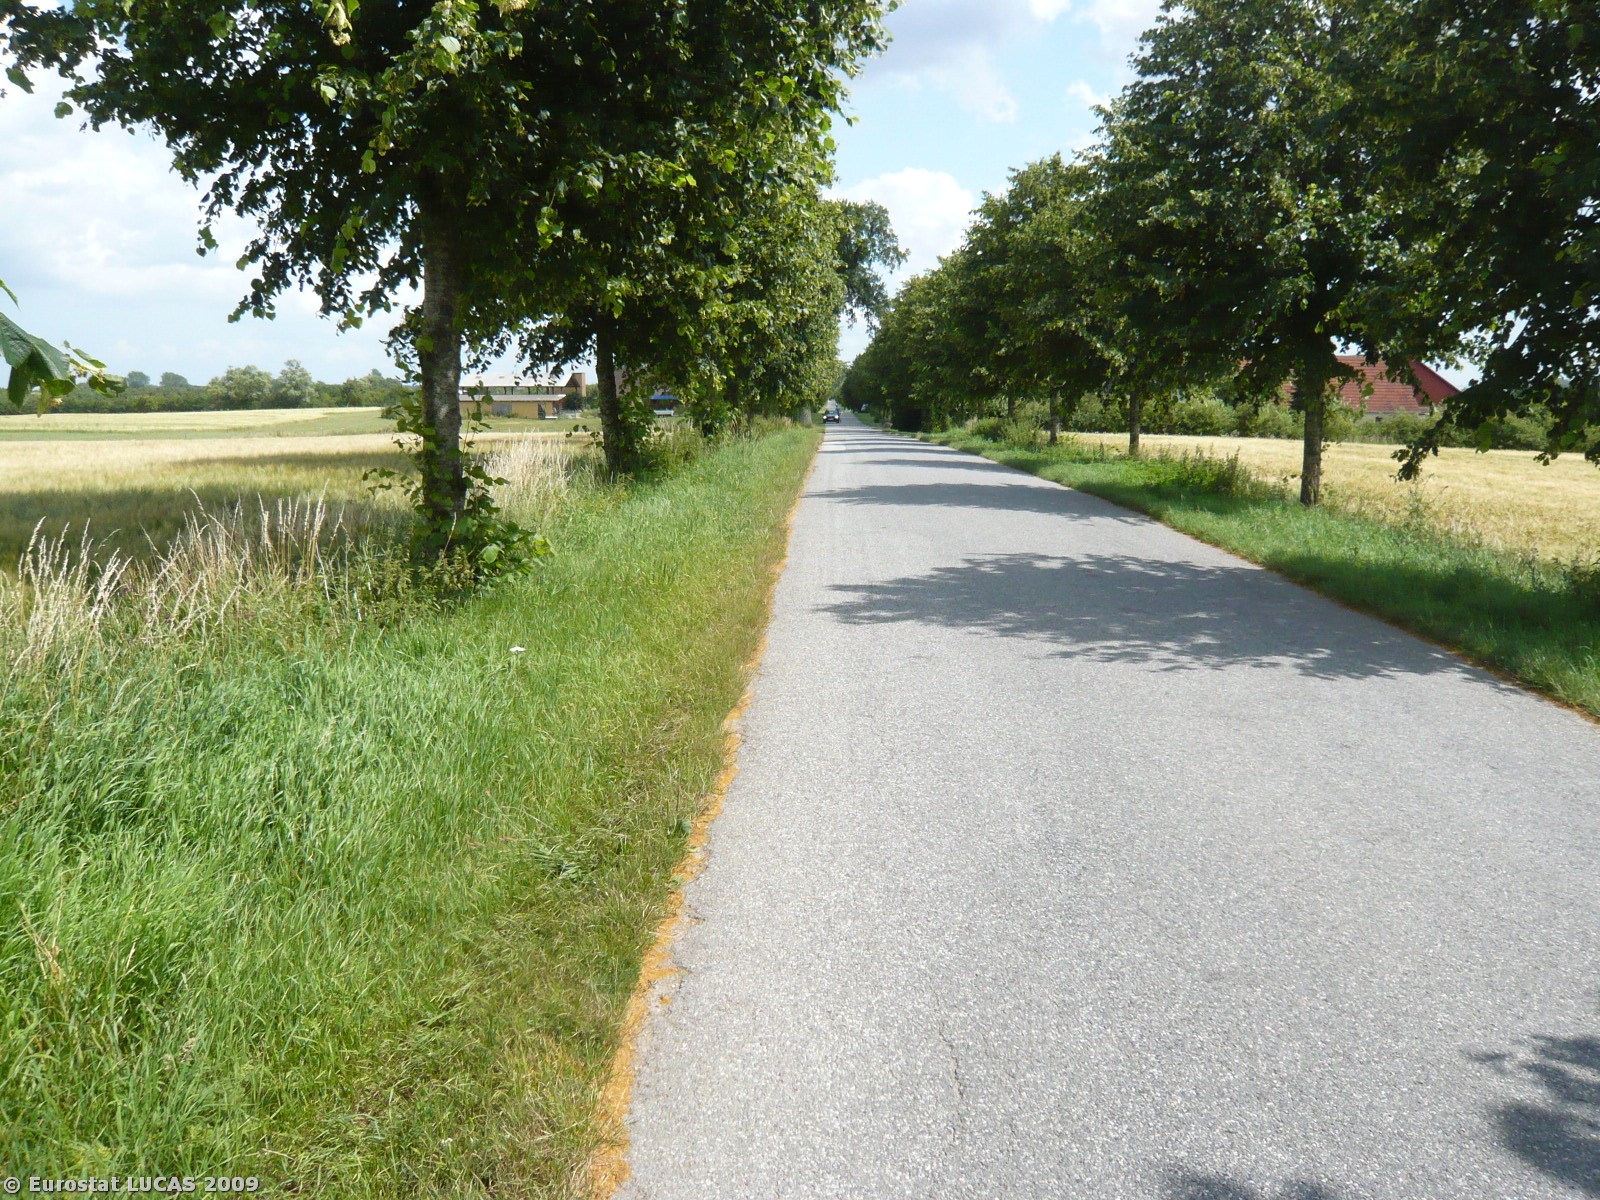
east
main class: Cropland
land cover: Barley
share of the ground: > 75 %
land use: Agriculture (excluding fallow land and kitchen gardens)
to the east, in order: Barley; Grass margins; Temporary grasslands
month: July
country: DK
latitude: 55.6923
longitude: 11.6052
